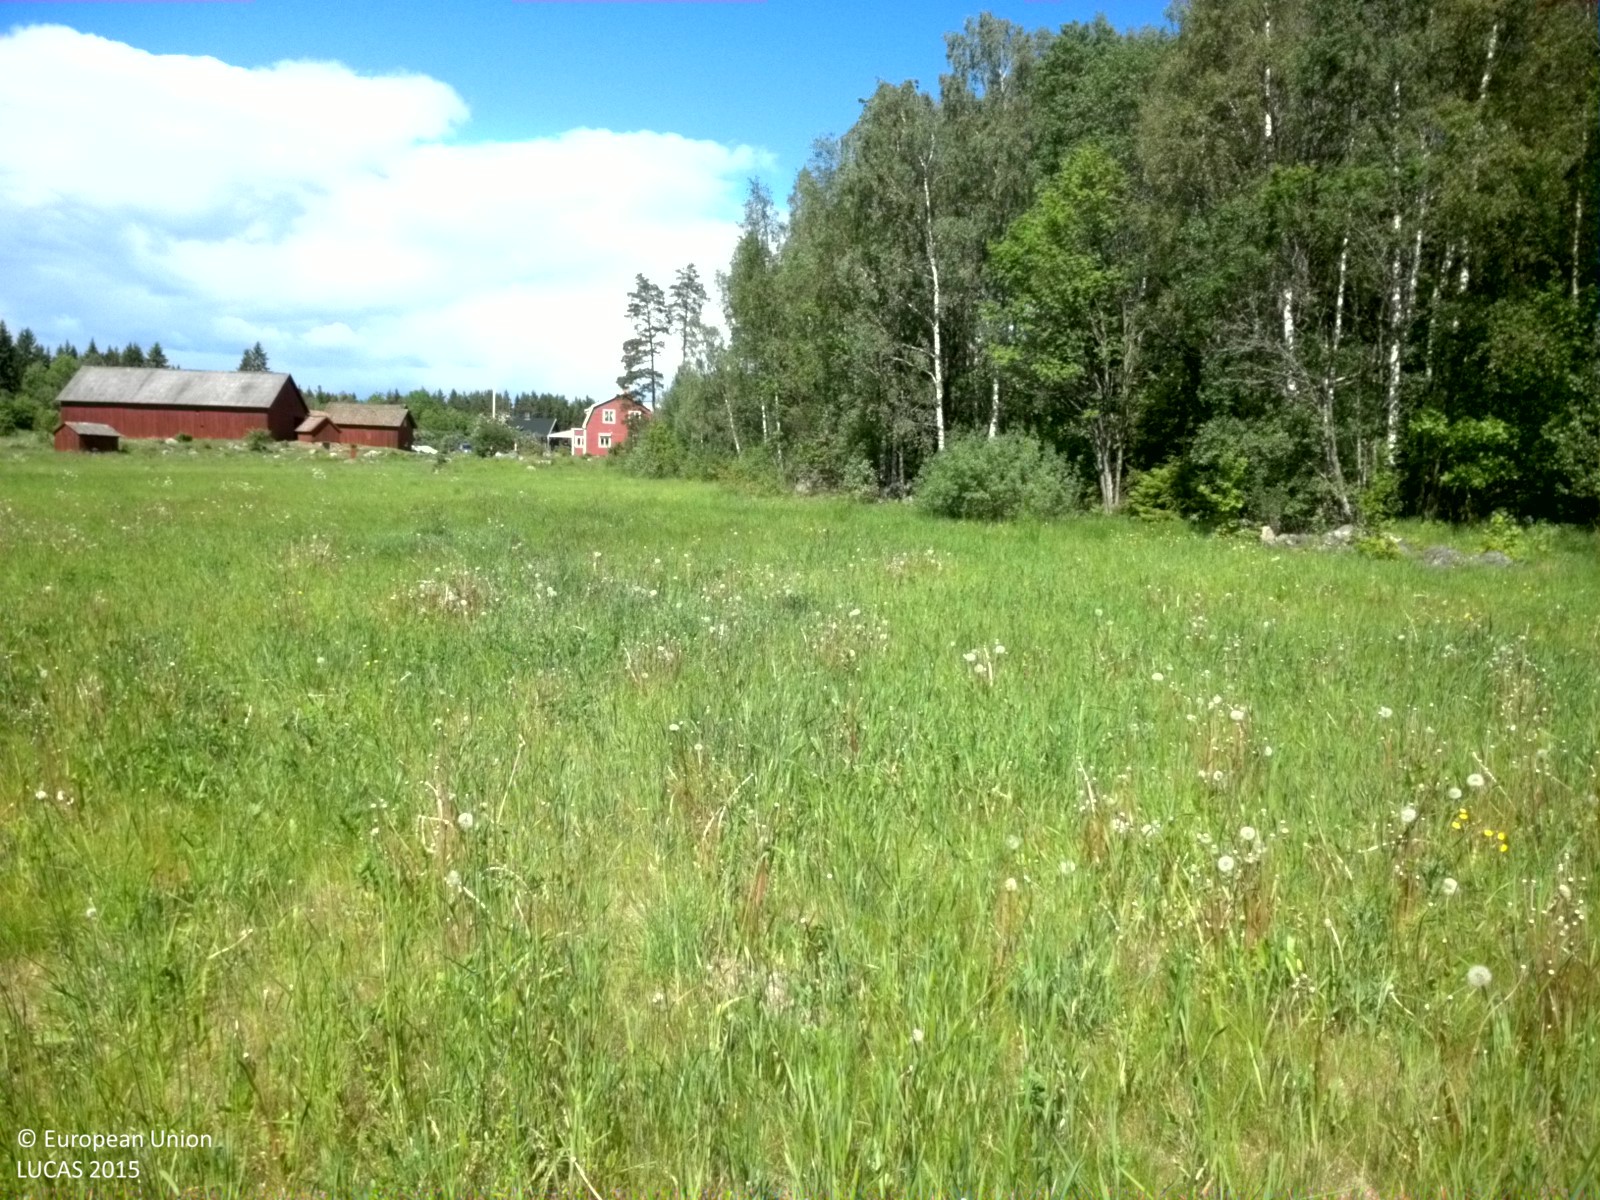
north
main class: Grassland
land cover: Grassland without tree/shrub cover
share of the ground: > 75 %
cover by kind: herbaceous plants 100 %
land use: Agriculture (excluding fallow land and kitchen gardens)
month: June
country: SE
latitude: 60.2335
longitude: 17.8484
